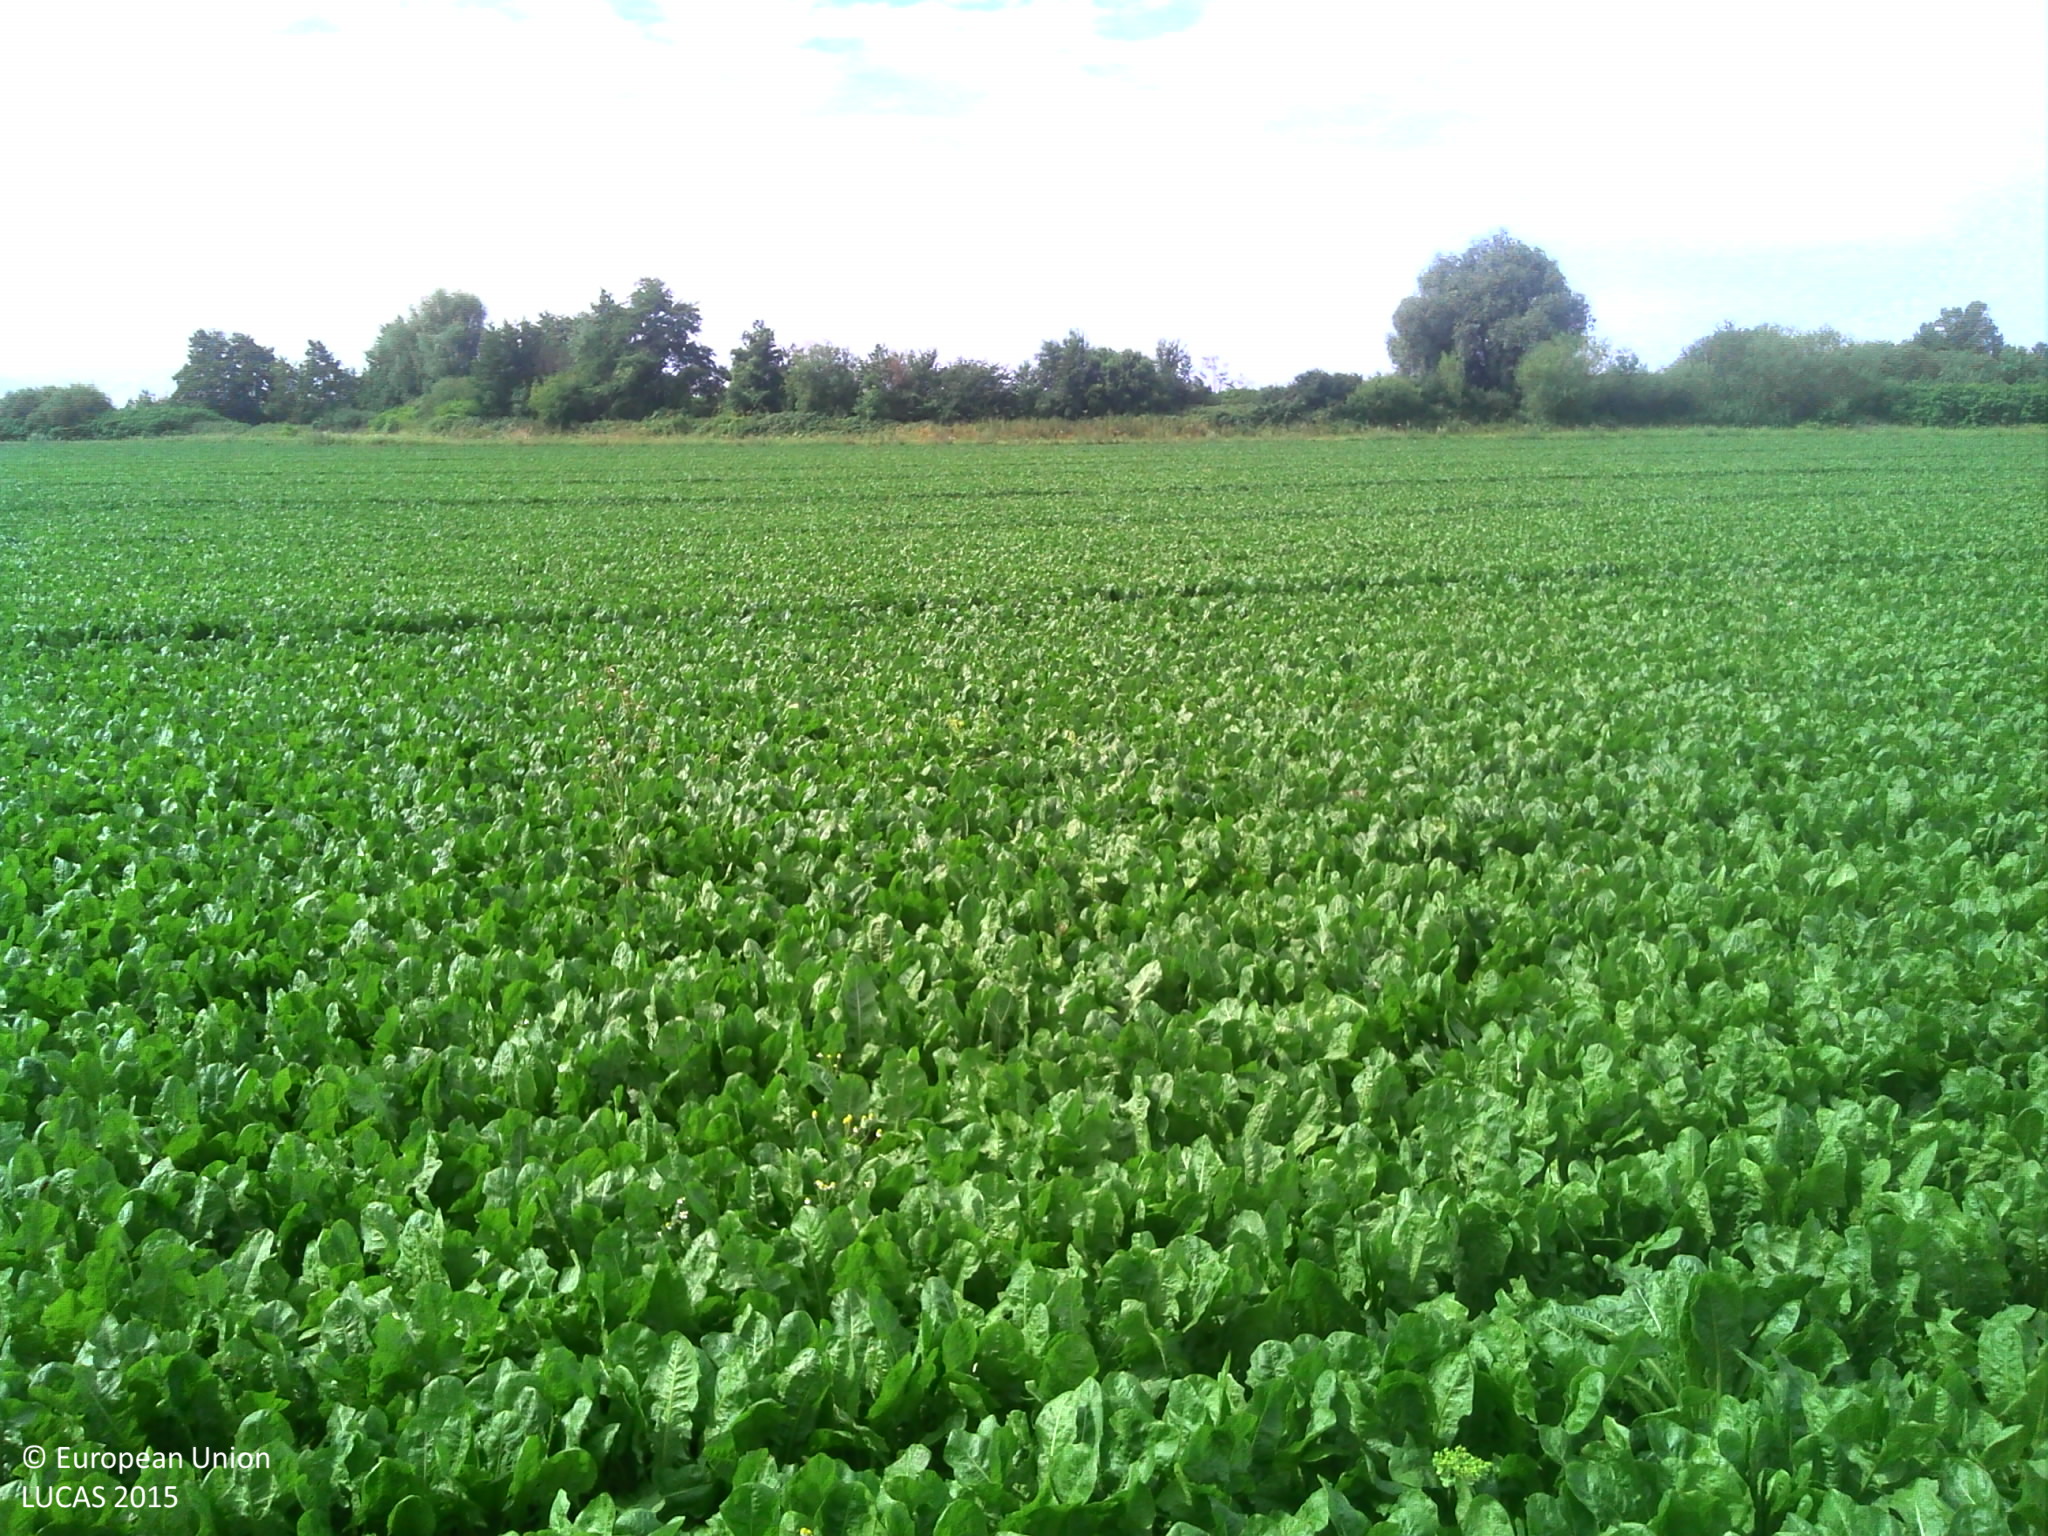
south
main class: Cropland
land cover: Sugar beet
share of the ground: > 75 %
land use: Agriculture (excluding fallow land and kitchen gardens)
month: July
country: FR
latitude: 49.6978
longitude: 3.6017
